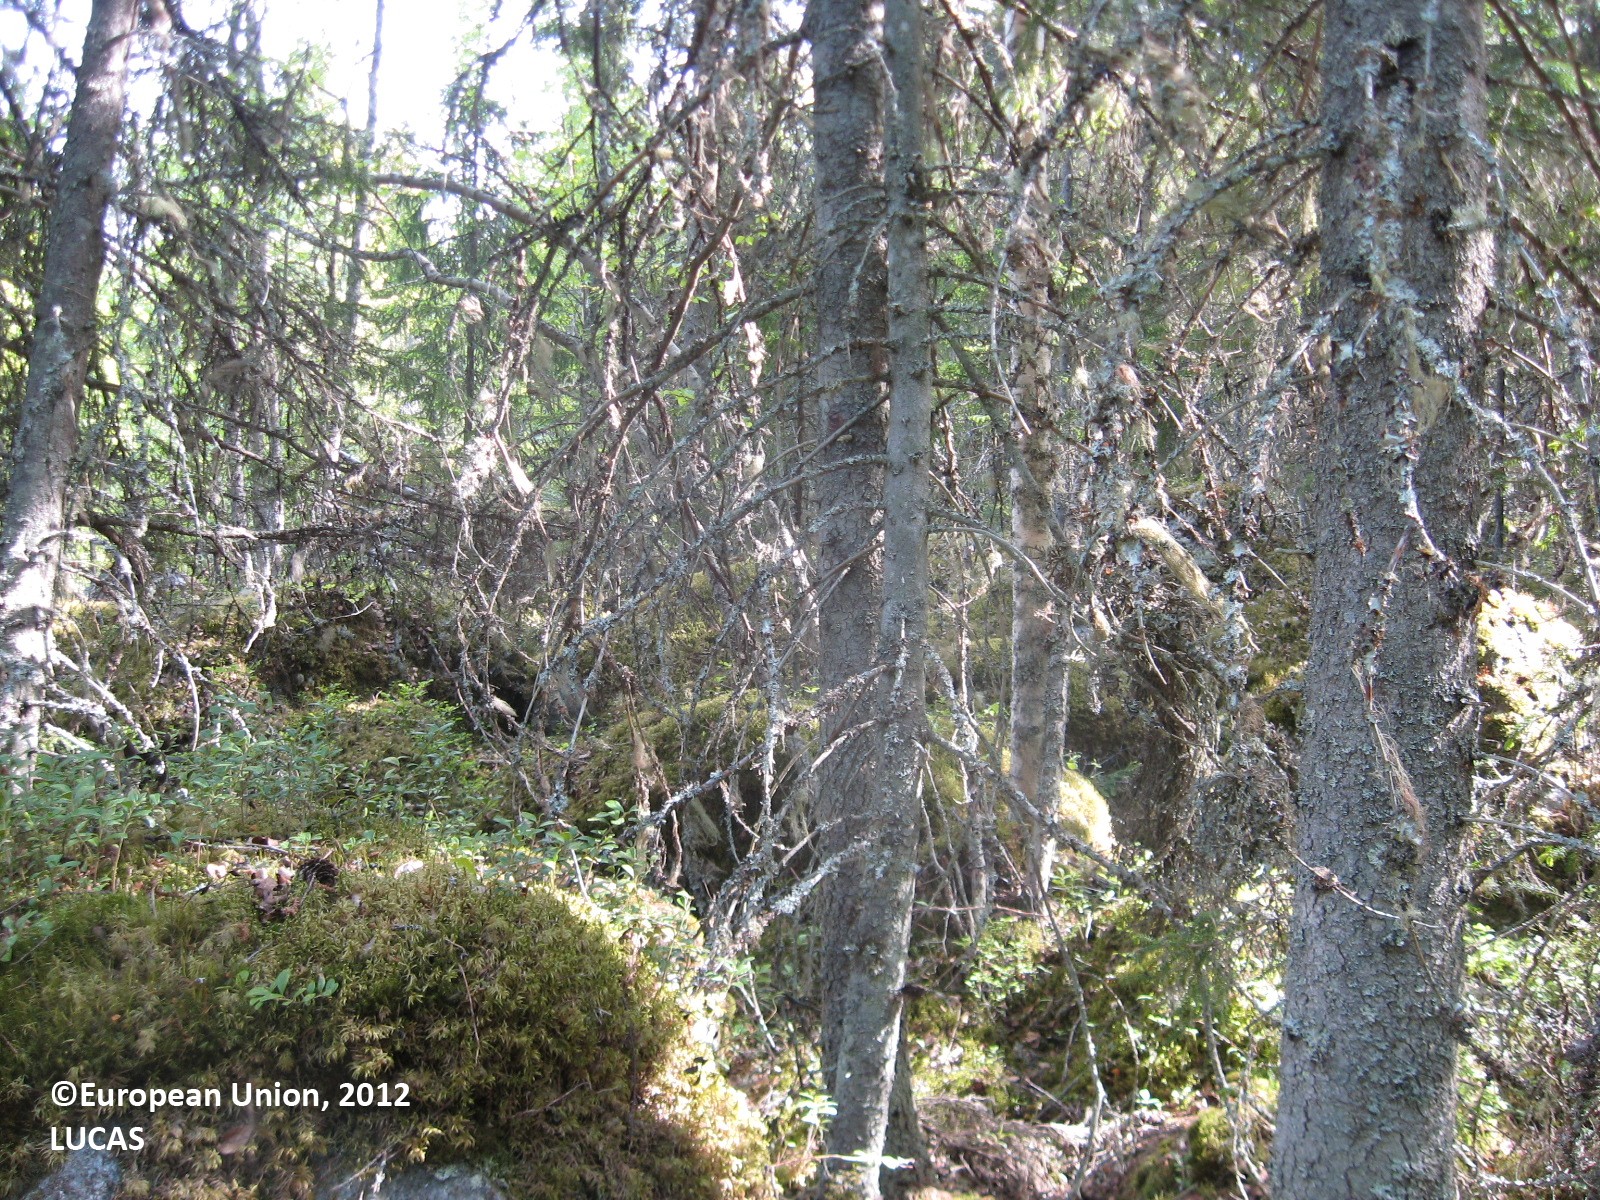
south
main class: Woodland
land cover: Spruce dominated mixed woodland
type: boreal forest
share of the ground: > 75 %
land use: Forestry
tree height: > 5 m
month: June
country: FI
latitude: 63.2157
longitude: 21.9171
